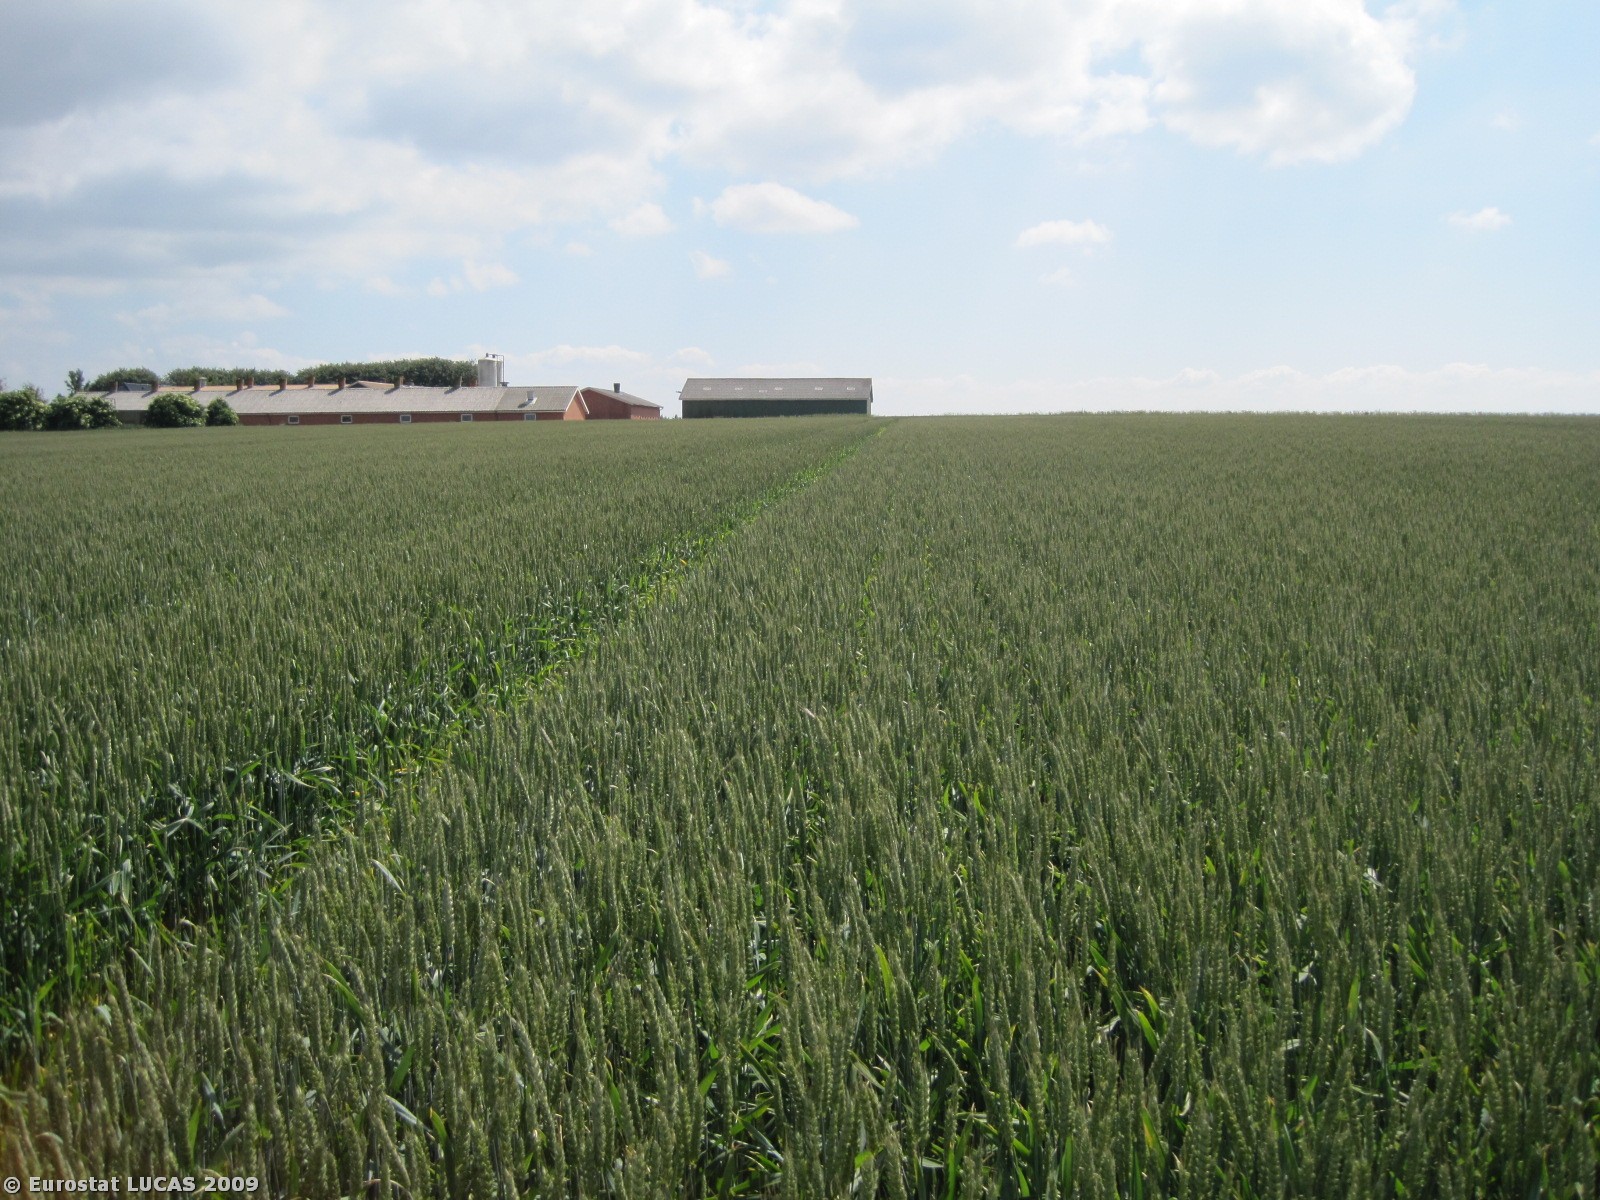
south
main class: Cropland
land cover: Common wheat
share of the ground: > 75 %
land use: Agriculture (excluding fallow land and kitchen gardens)
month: June
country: DK
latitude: 56.5427
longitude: 8.9117
